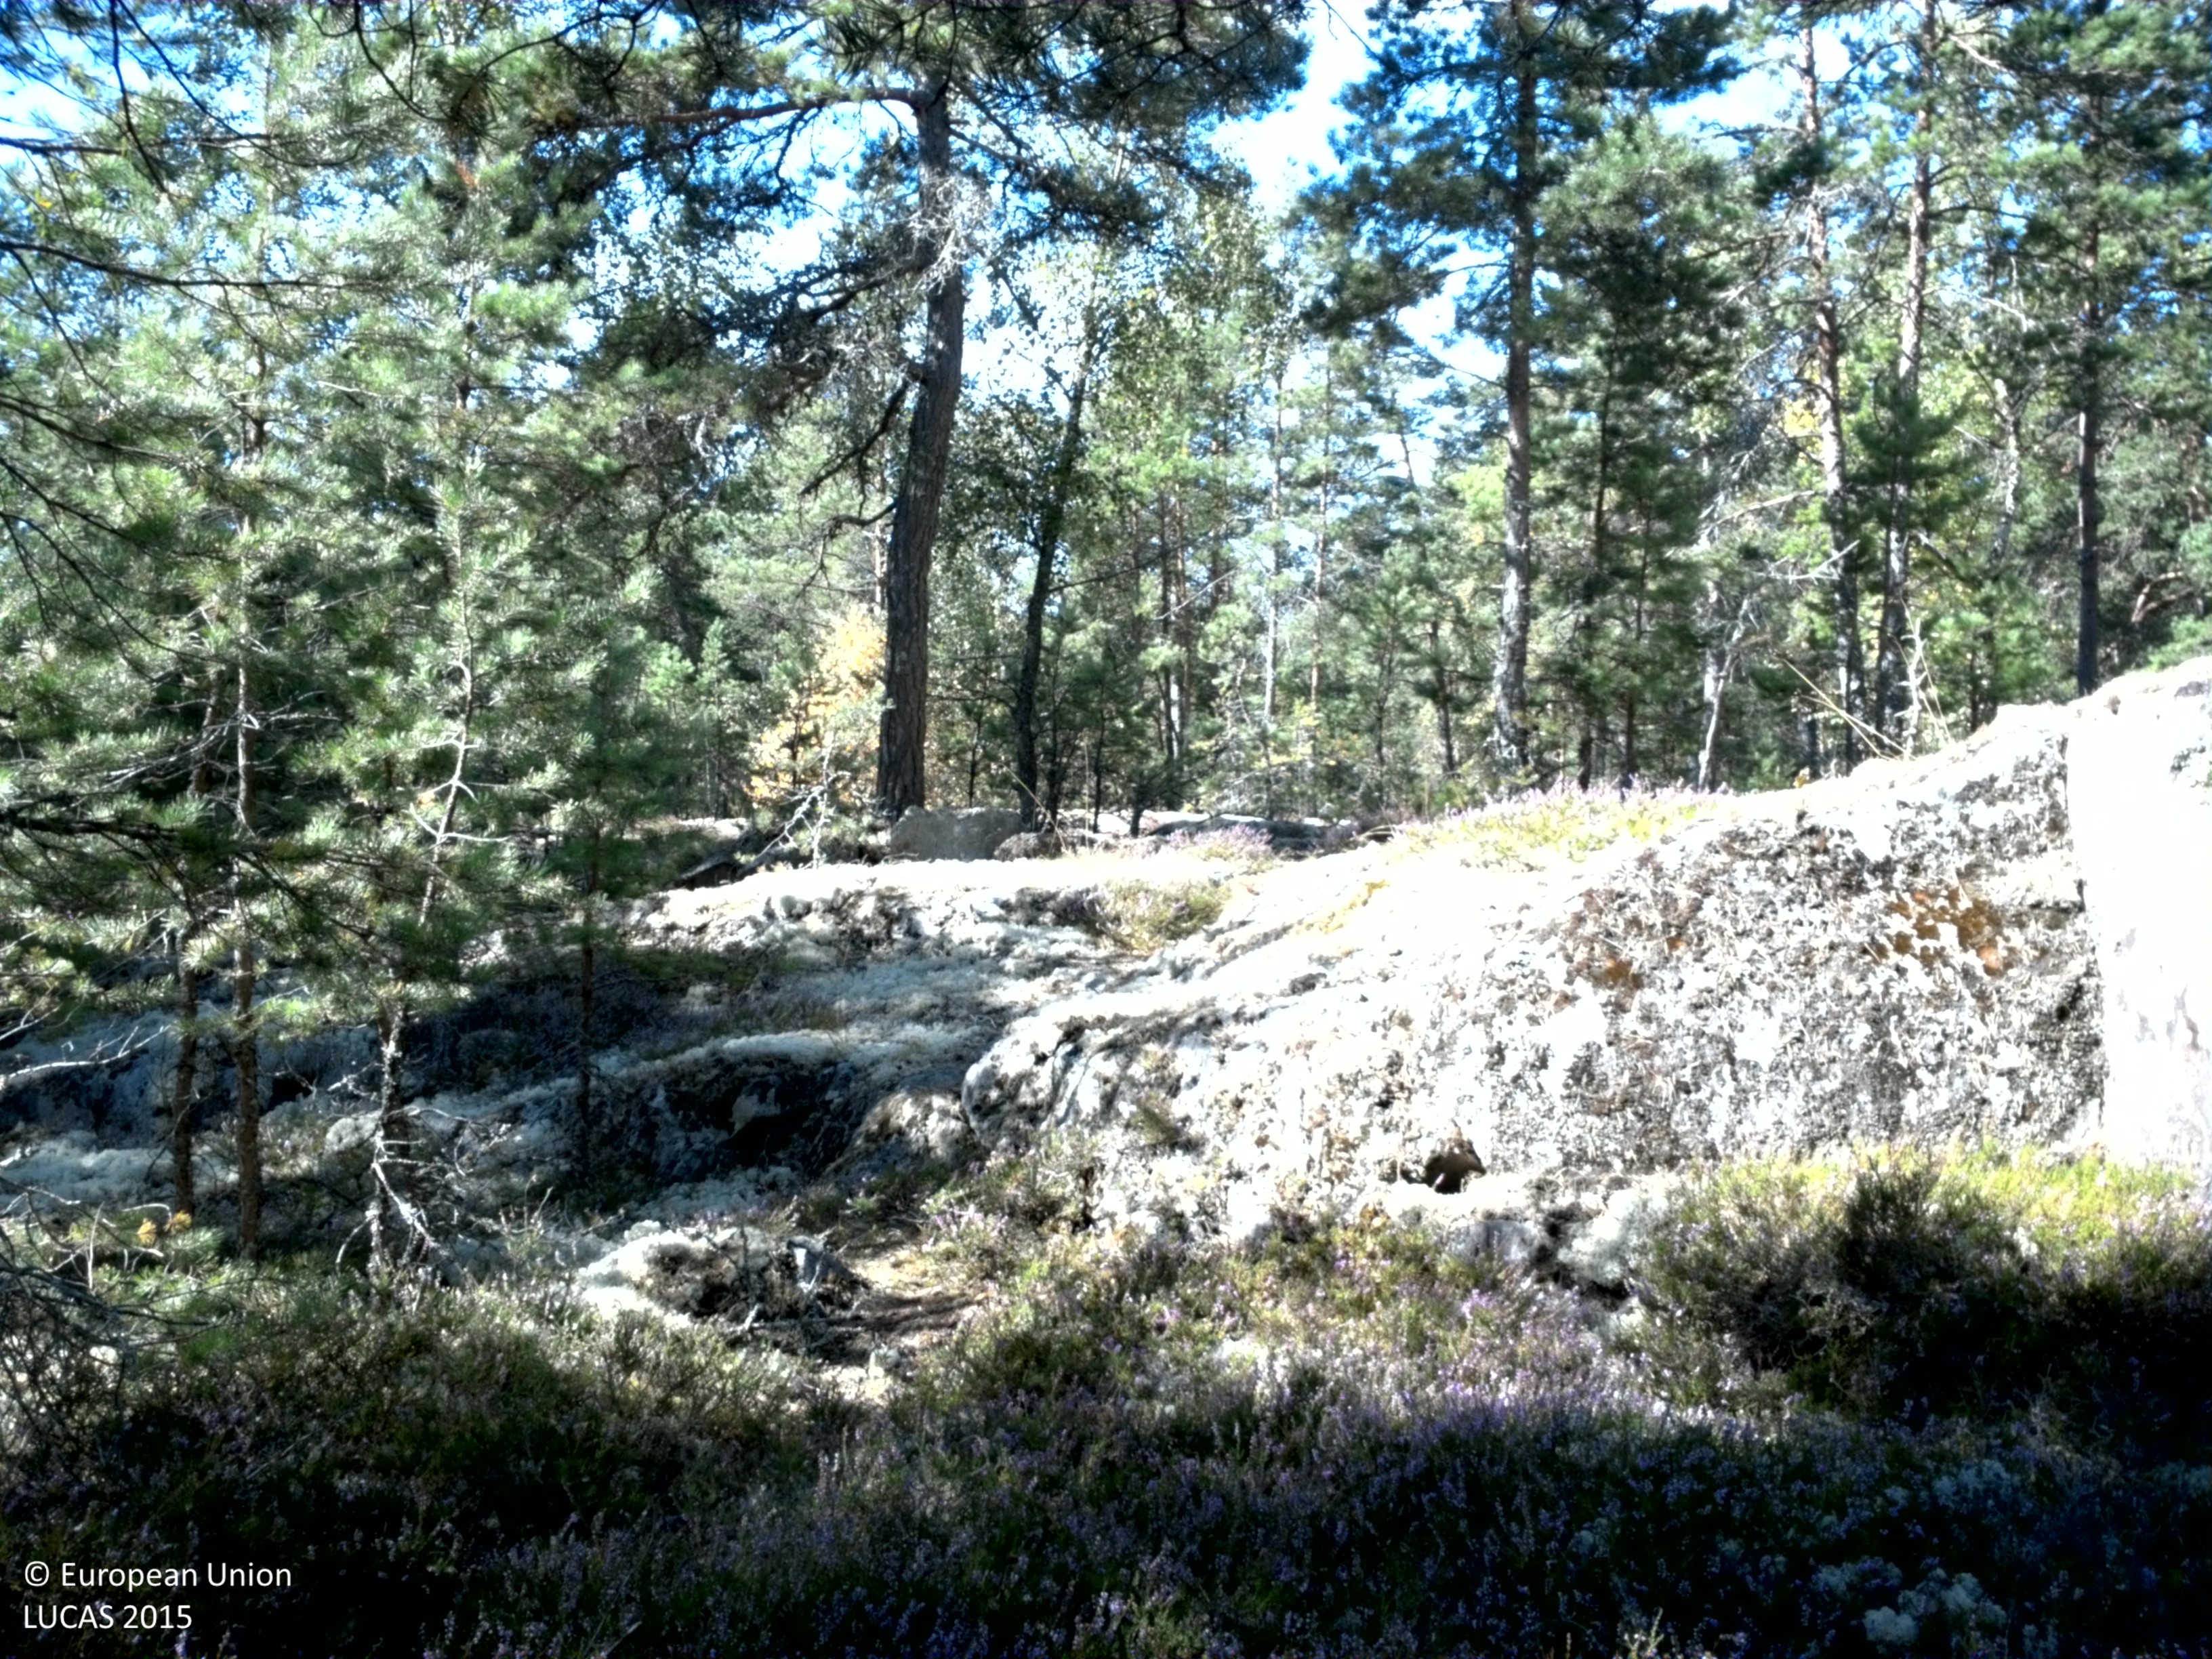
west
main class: Woodland
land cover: Pine dominated coniferous woodland
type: boreal forest
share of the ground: > 75 %
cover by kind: coniferous forest trees 60 %, lichens and mosses 25 %, shrubs 10 %, broadleaved forest trees 5 %
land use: Amenities, museums, leisure
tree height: > 5 m
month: August
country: SE
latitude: 59.4452
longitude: 17.7033
